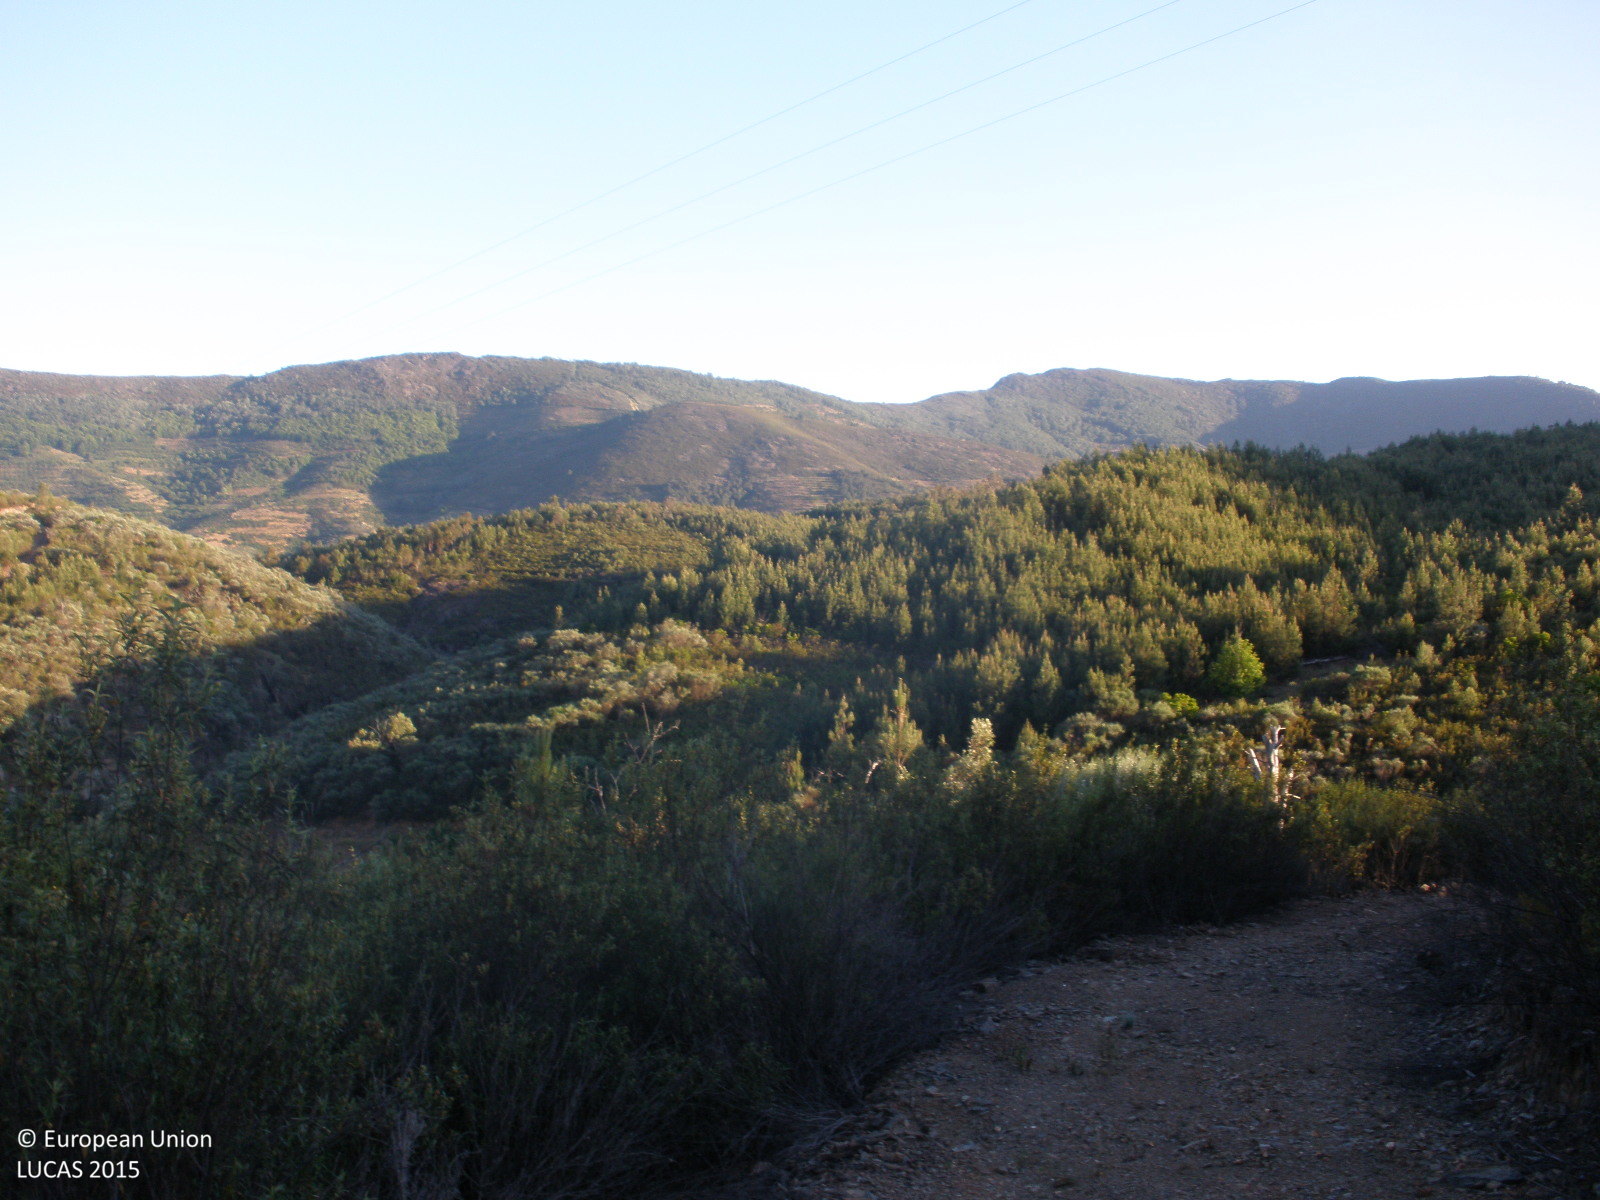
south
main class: Shrubland
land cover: Shrubland with sparse tree cover
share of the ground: > 75 %
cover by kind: shrubs 95 %, coniferous forest trees 5 %
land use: Semi-natural and natural areas not in use
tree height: < 5 m
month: May
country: ES
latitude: 40.3142
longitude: -6.2836
